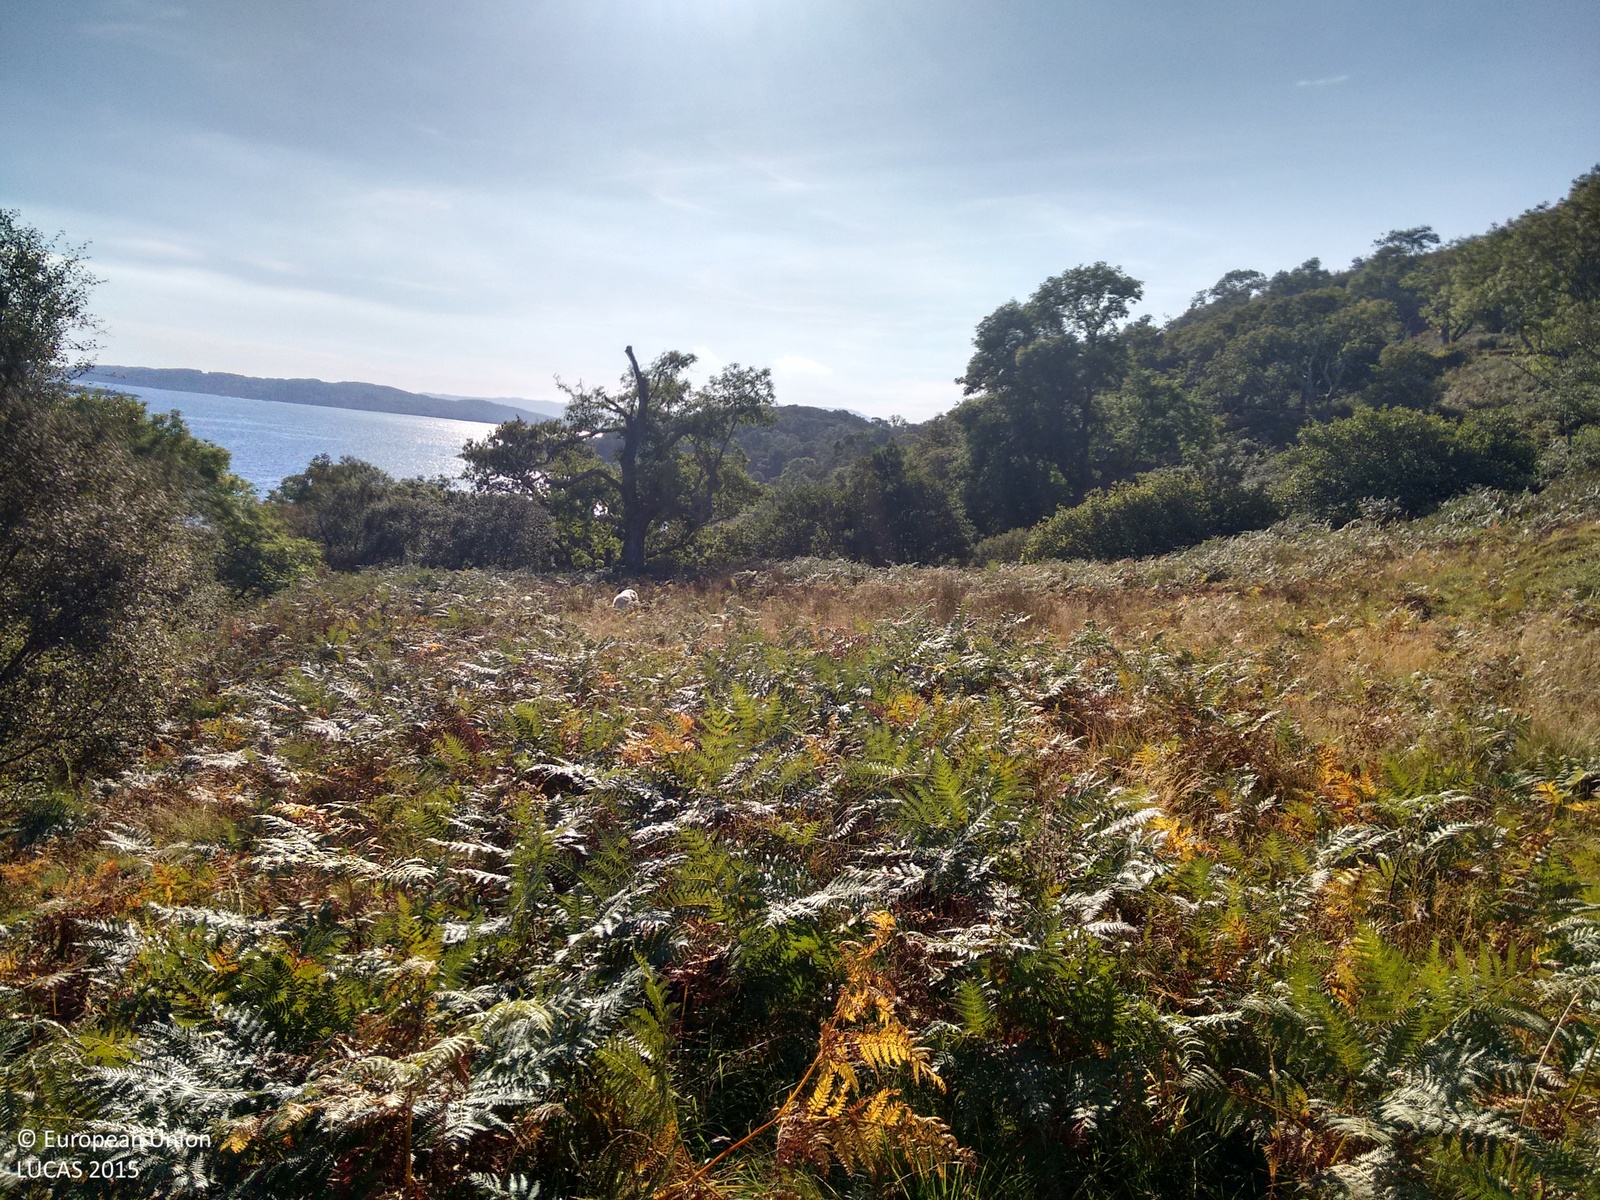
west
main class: Woodland
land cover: Broadleaved woodland
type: non-riverine alder, birch or aspen forest
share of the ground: > 75 %
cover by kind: broadleaved forest trees 95 %, shrubs 5 %
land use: Semi-natural and natural areas not in use
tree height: > 5 m
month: August
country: GB
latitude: 56.2565
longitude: -5.5710
